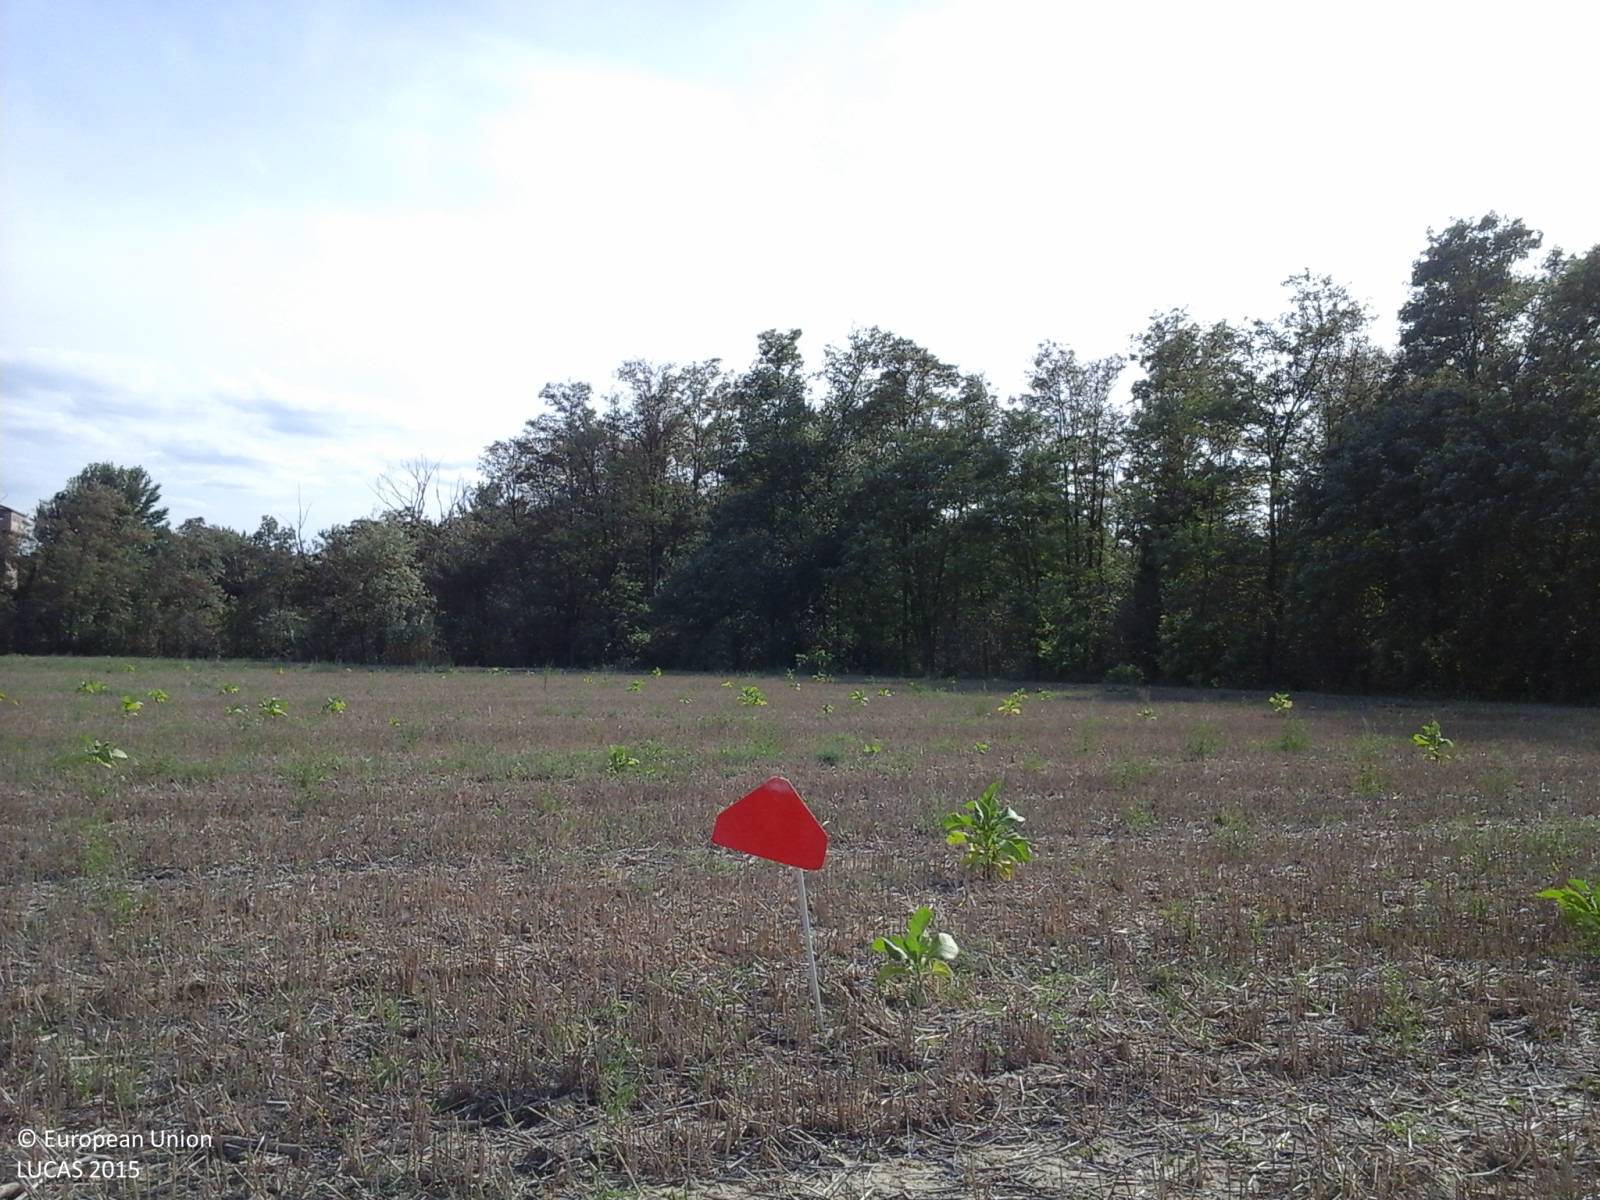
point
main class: Cropland
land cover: Durum wheat
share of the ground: < 10 %
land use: Agriculture (excluding fallow land and kitchen gardens)
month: September
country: IT
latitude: 43.1281
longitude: 12.5373
